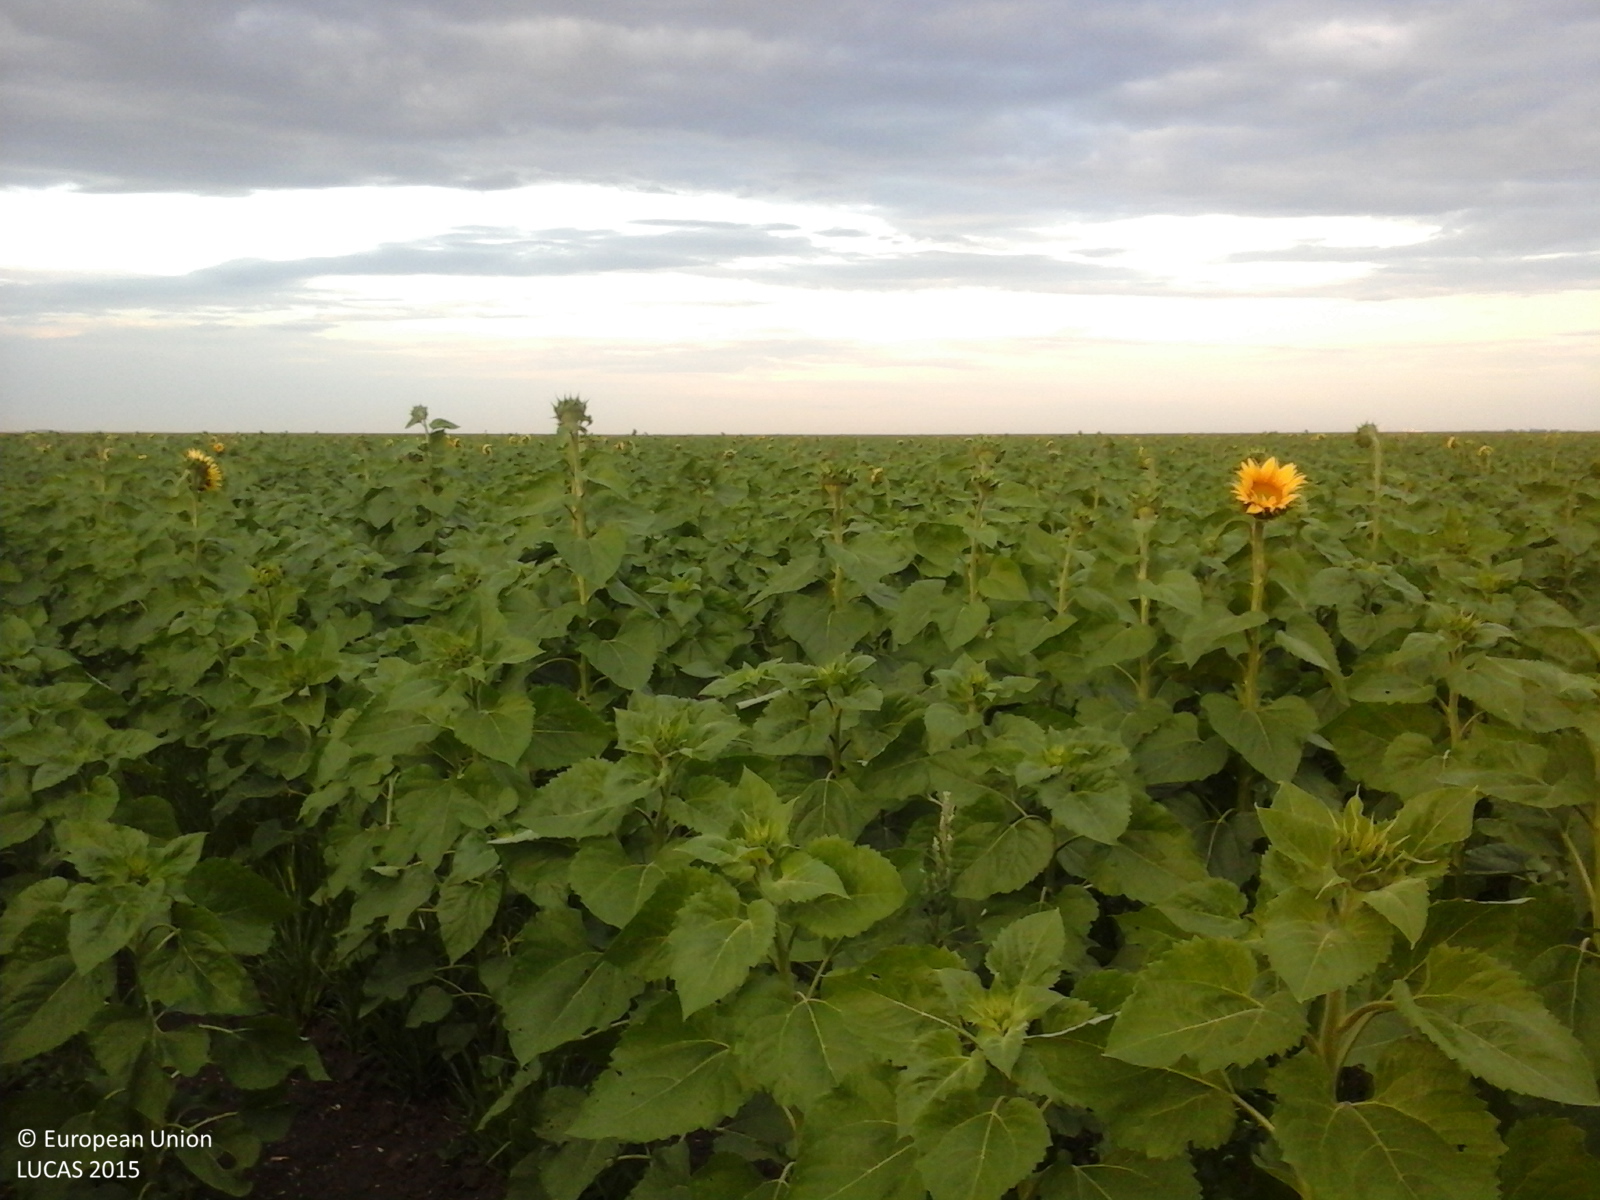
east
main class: Cropland
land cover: Sunflower
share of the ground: > 75 %
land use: Agriculture (excluding fallow land and kitchen gardens)
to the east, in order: Sunflower
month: July
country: RO
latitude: 44.1413
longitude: 24.8120
